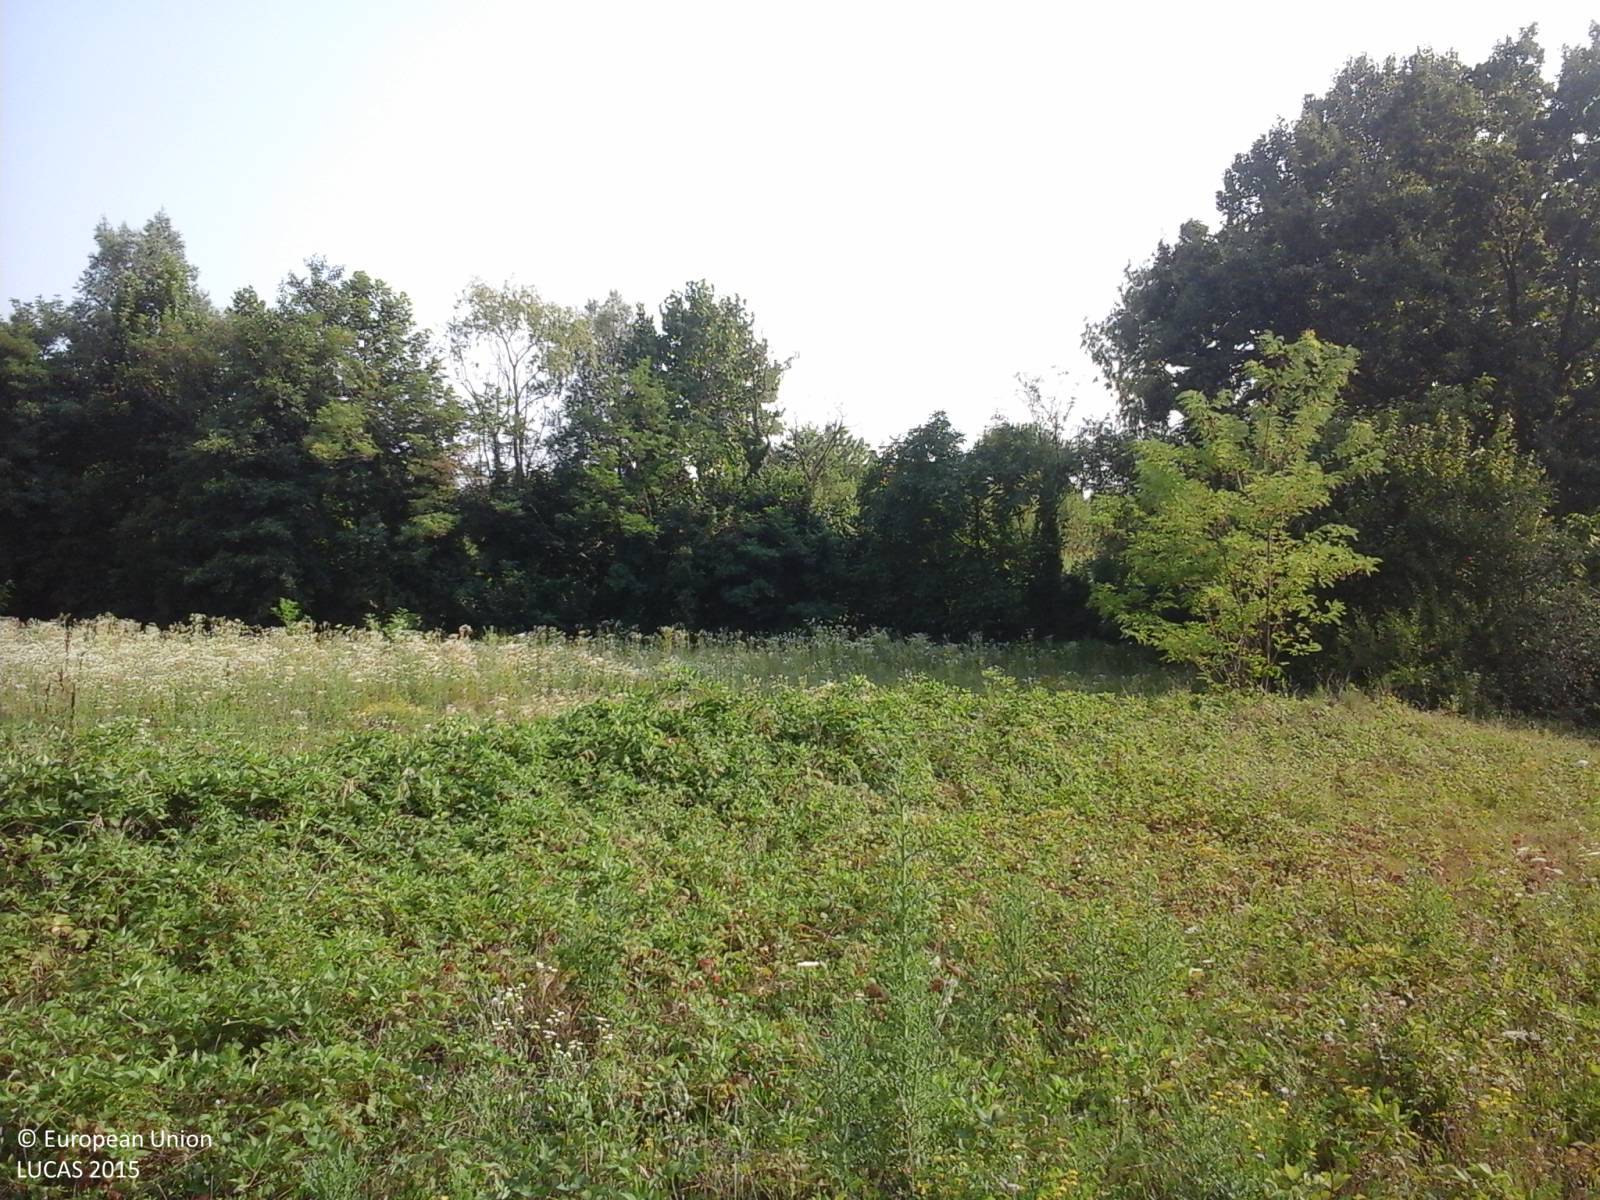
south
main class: Grassland
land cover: Spontaneously vegetated surfaces
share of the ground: > 75 %
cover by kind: herbaceous plants 100 %
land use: Fallow land
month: July
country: IT
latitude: 45.9022
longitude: 12.7162
